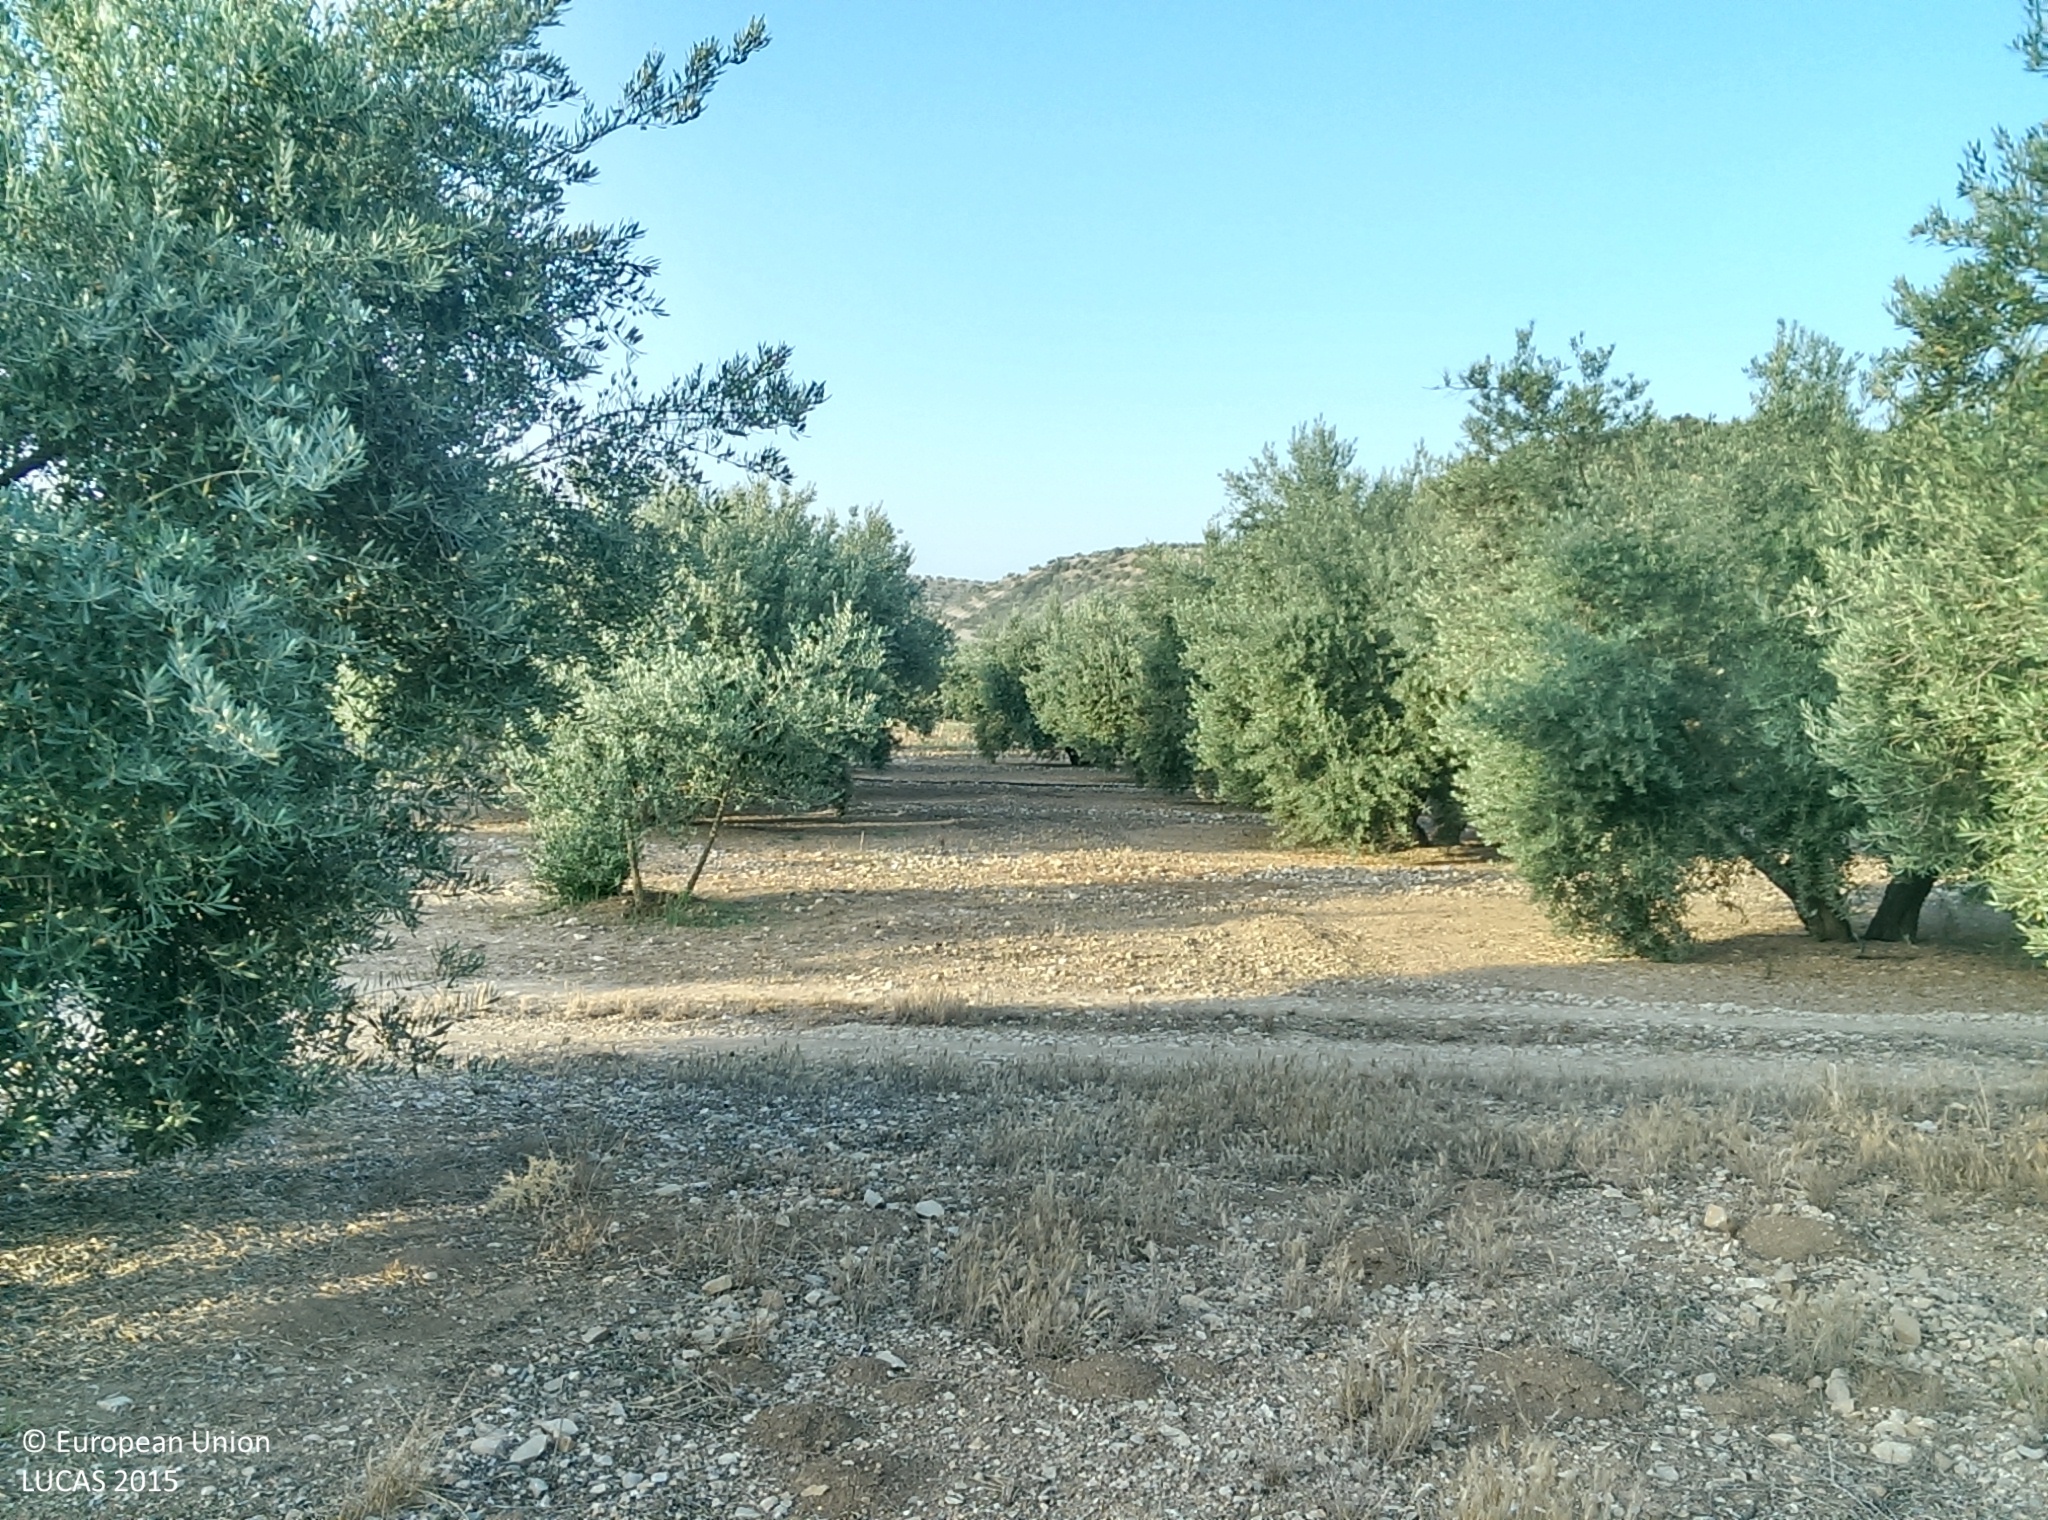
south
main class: Cropland
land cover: Olive groves
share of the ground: 50 - 75 %
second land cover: Other bare soil
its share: > 75 %
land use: Agriculture (excluding fallow land and kitchen gardens)
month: July
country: ES
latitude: 37.3198
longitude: -3.7032
